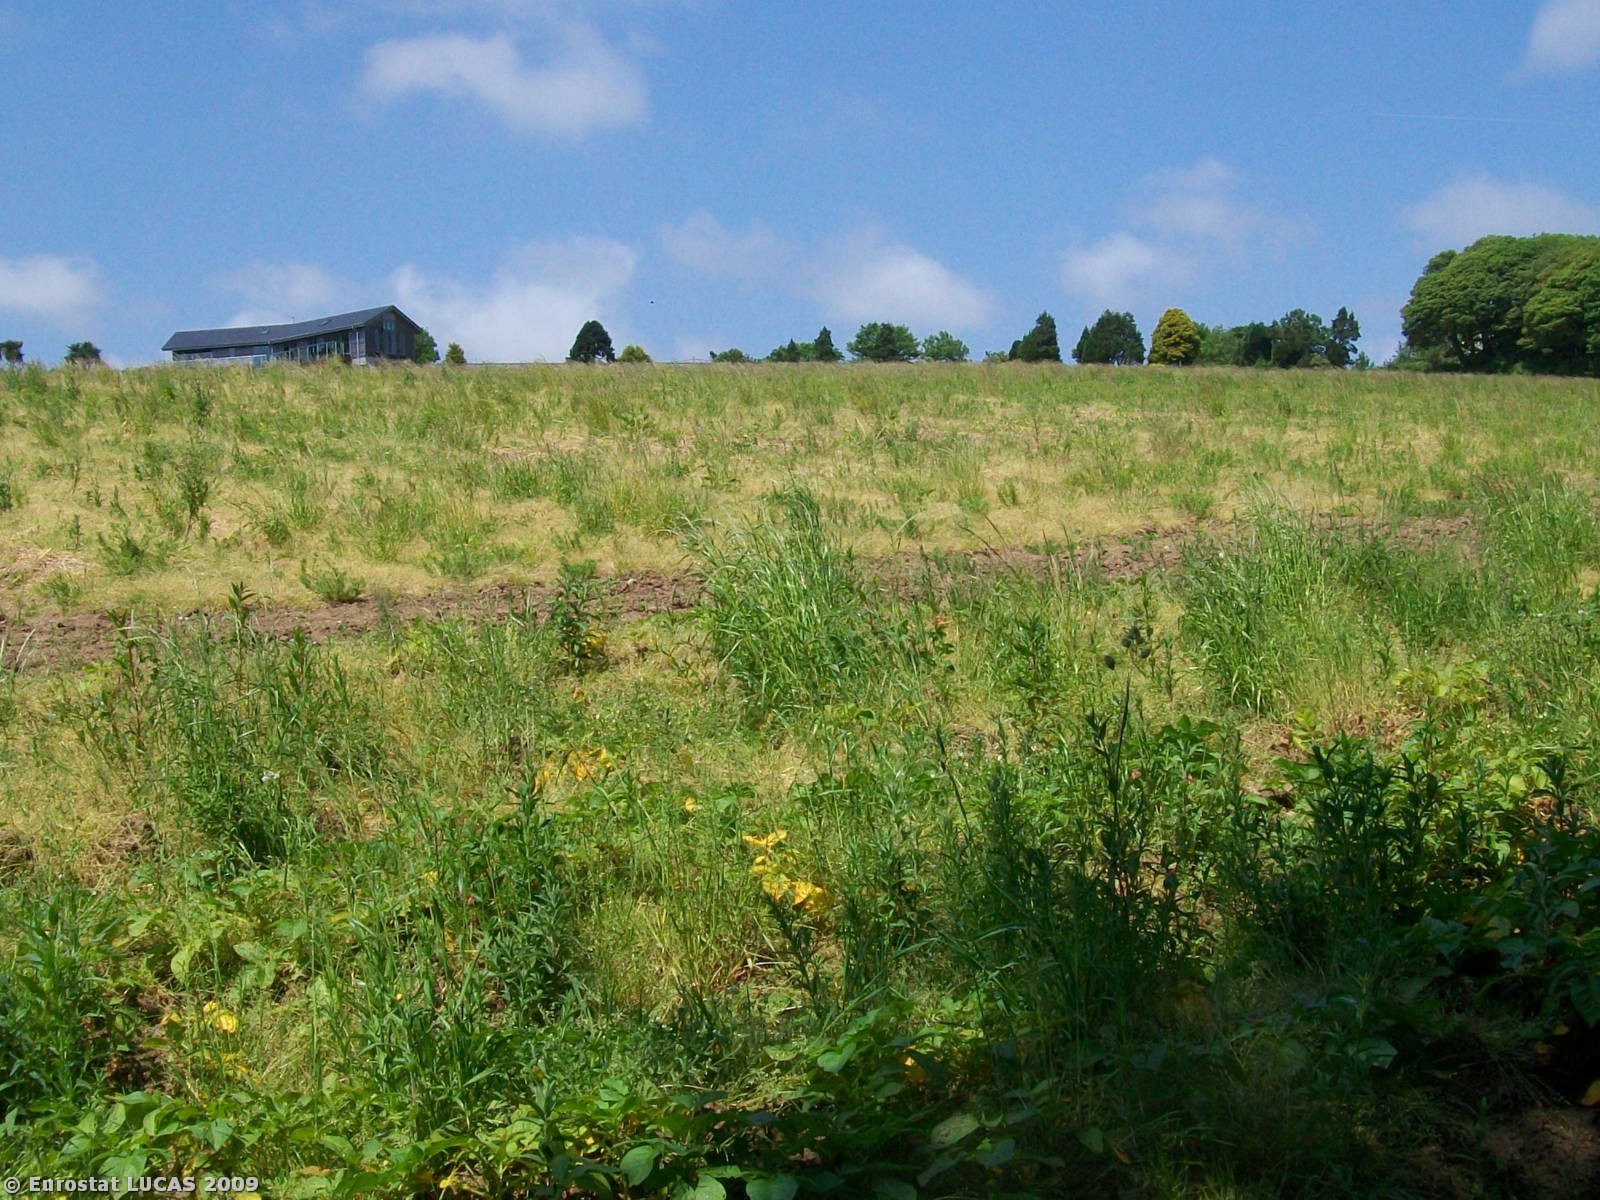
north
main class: Grassland
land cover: Spontaneously vegetated surfaces
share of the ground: > 75 %
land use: Fallow land
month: June
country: GB
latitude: 50.1929
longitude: -5.1202
